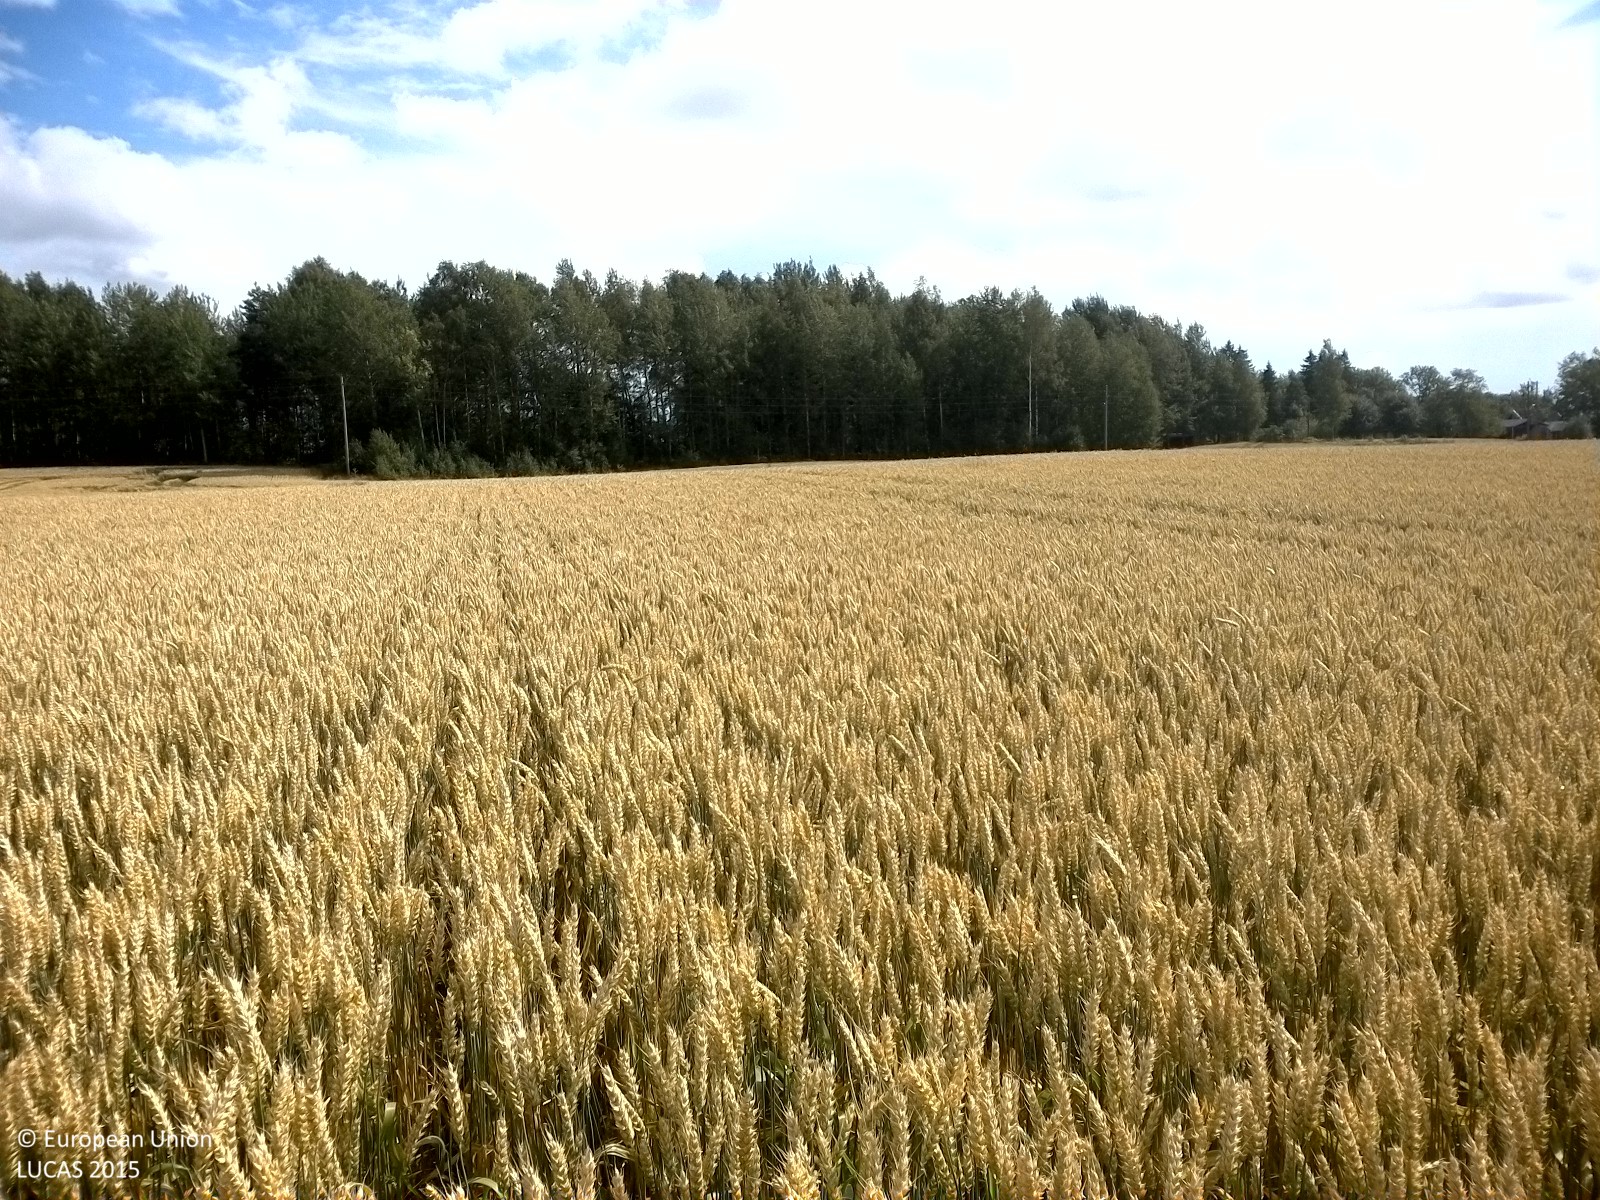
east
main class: Cropland
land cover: Common wheat
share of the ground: > 75 %
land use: Agriculture (excluding fallow land and kitchen gardens)
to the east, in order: Common wheat; Electric lines; Common wheat; Broadleaved woodland; Grass margins; Paved roads, cycling and walking lanes
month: August
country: SE
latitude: 59.1692
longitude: 15.0824
